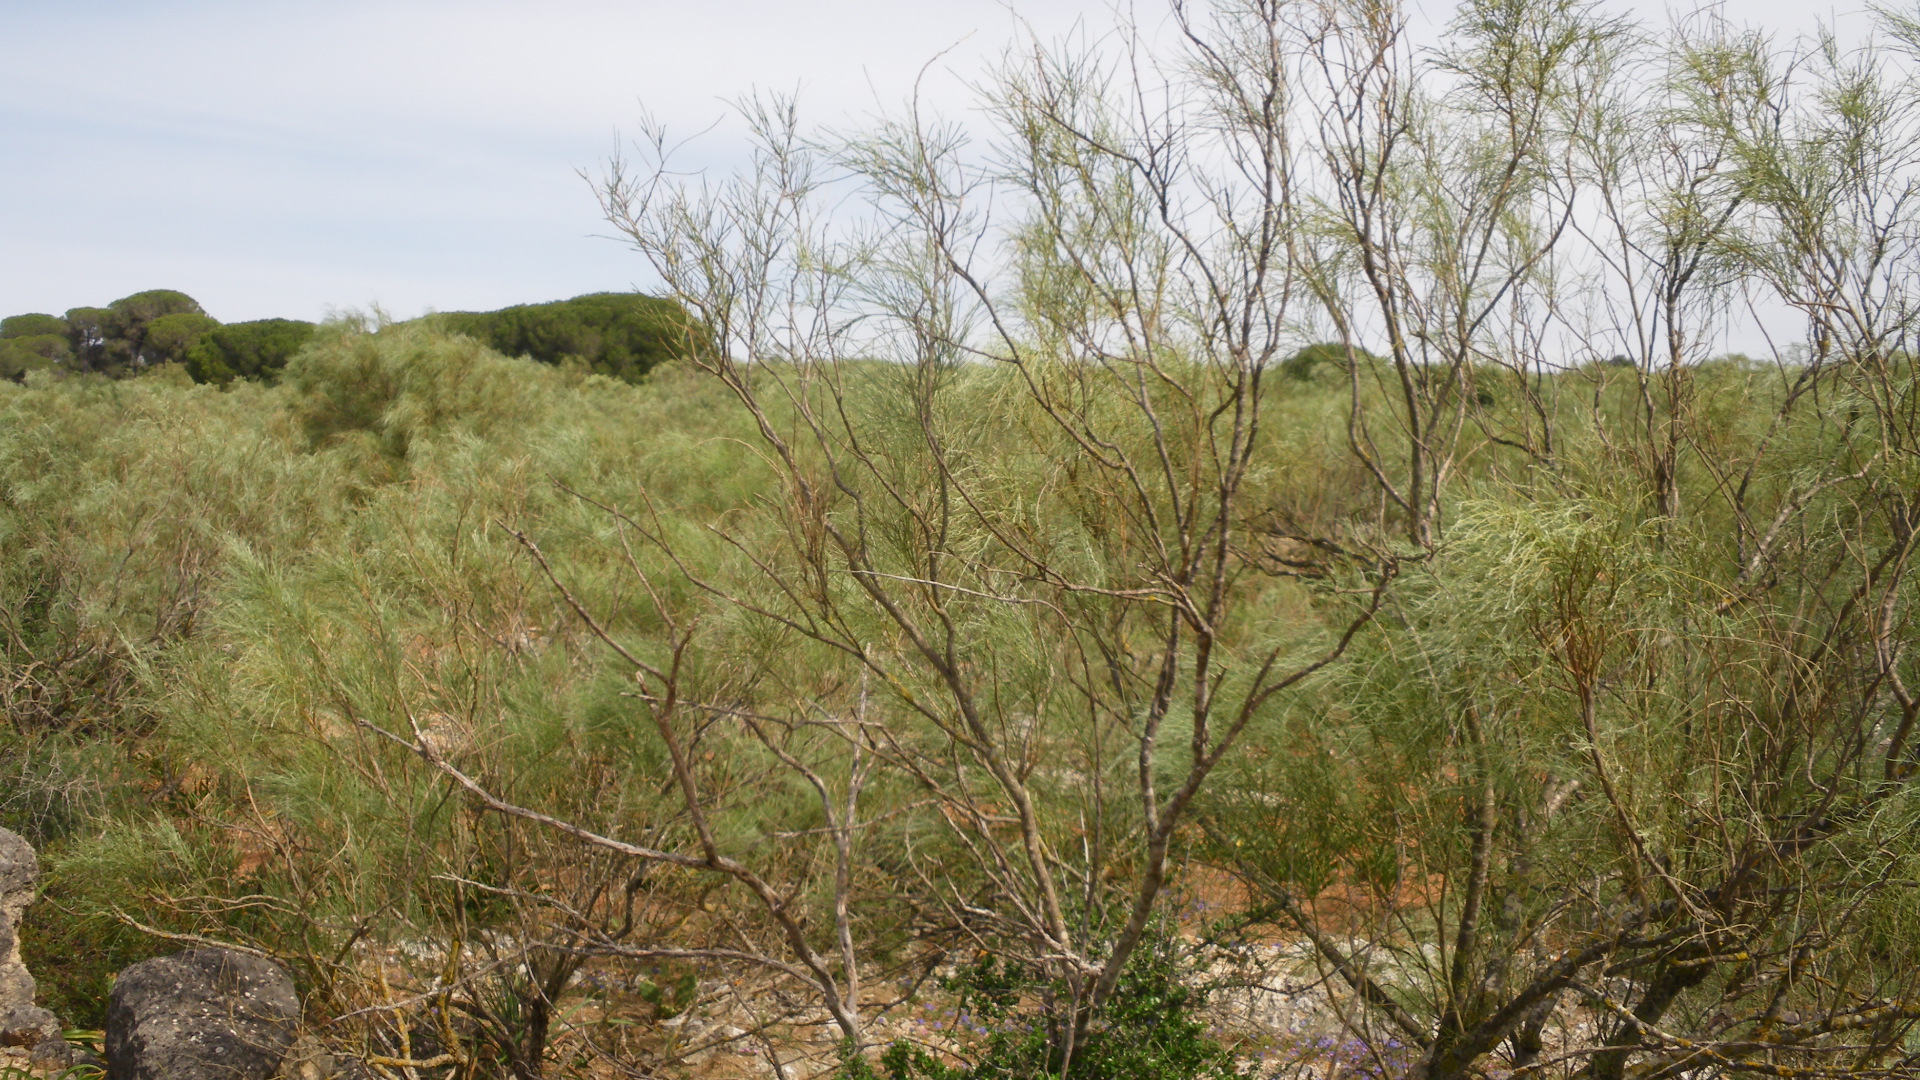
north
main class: Shrubland
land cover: Shrubland without tree cover
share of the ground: 25 - 50 %
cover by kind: shrubs 50 %, consolidated bare surface 30 %, herbaceous plants 20 %
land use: Semi-natural and natural areas not in use
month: April
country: ES
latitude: 36.6303
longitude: -6.1713
